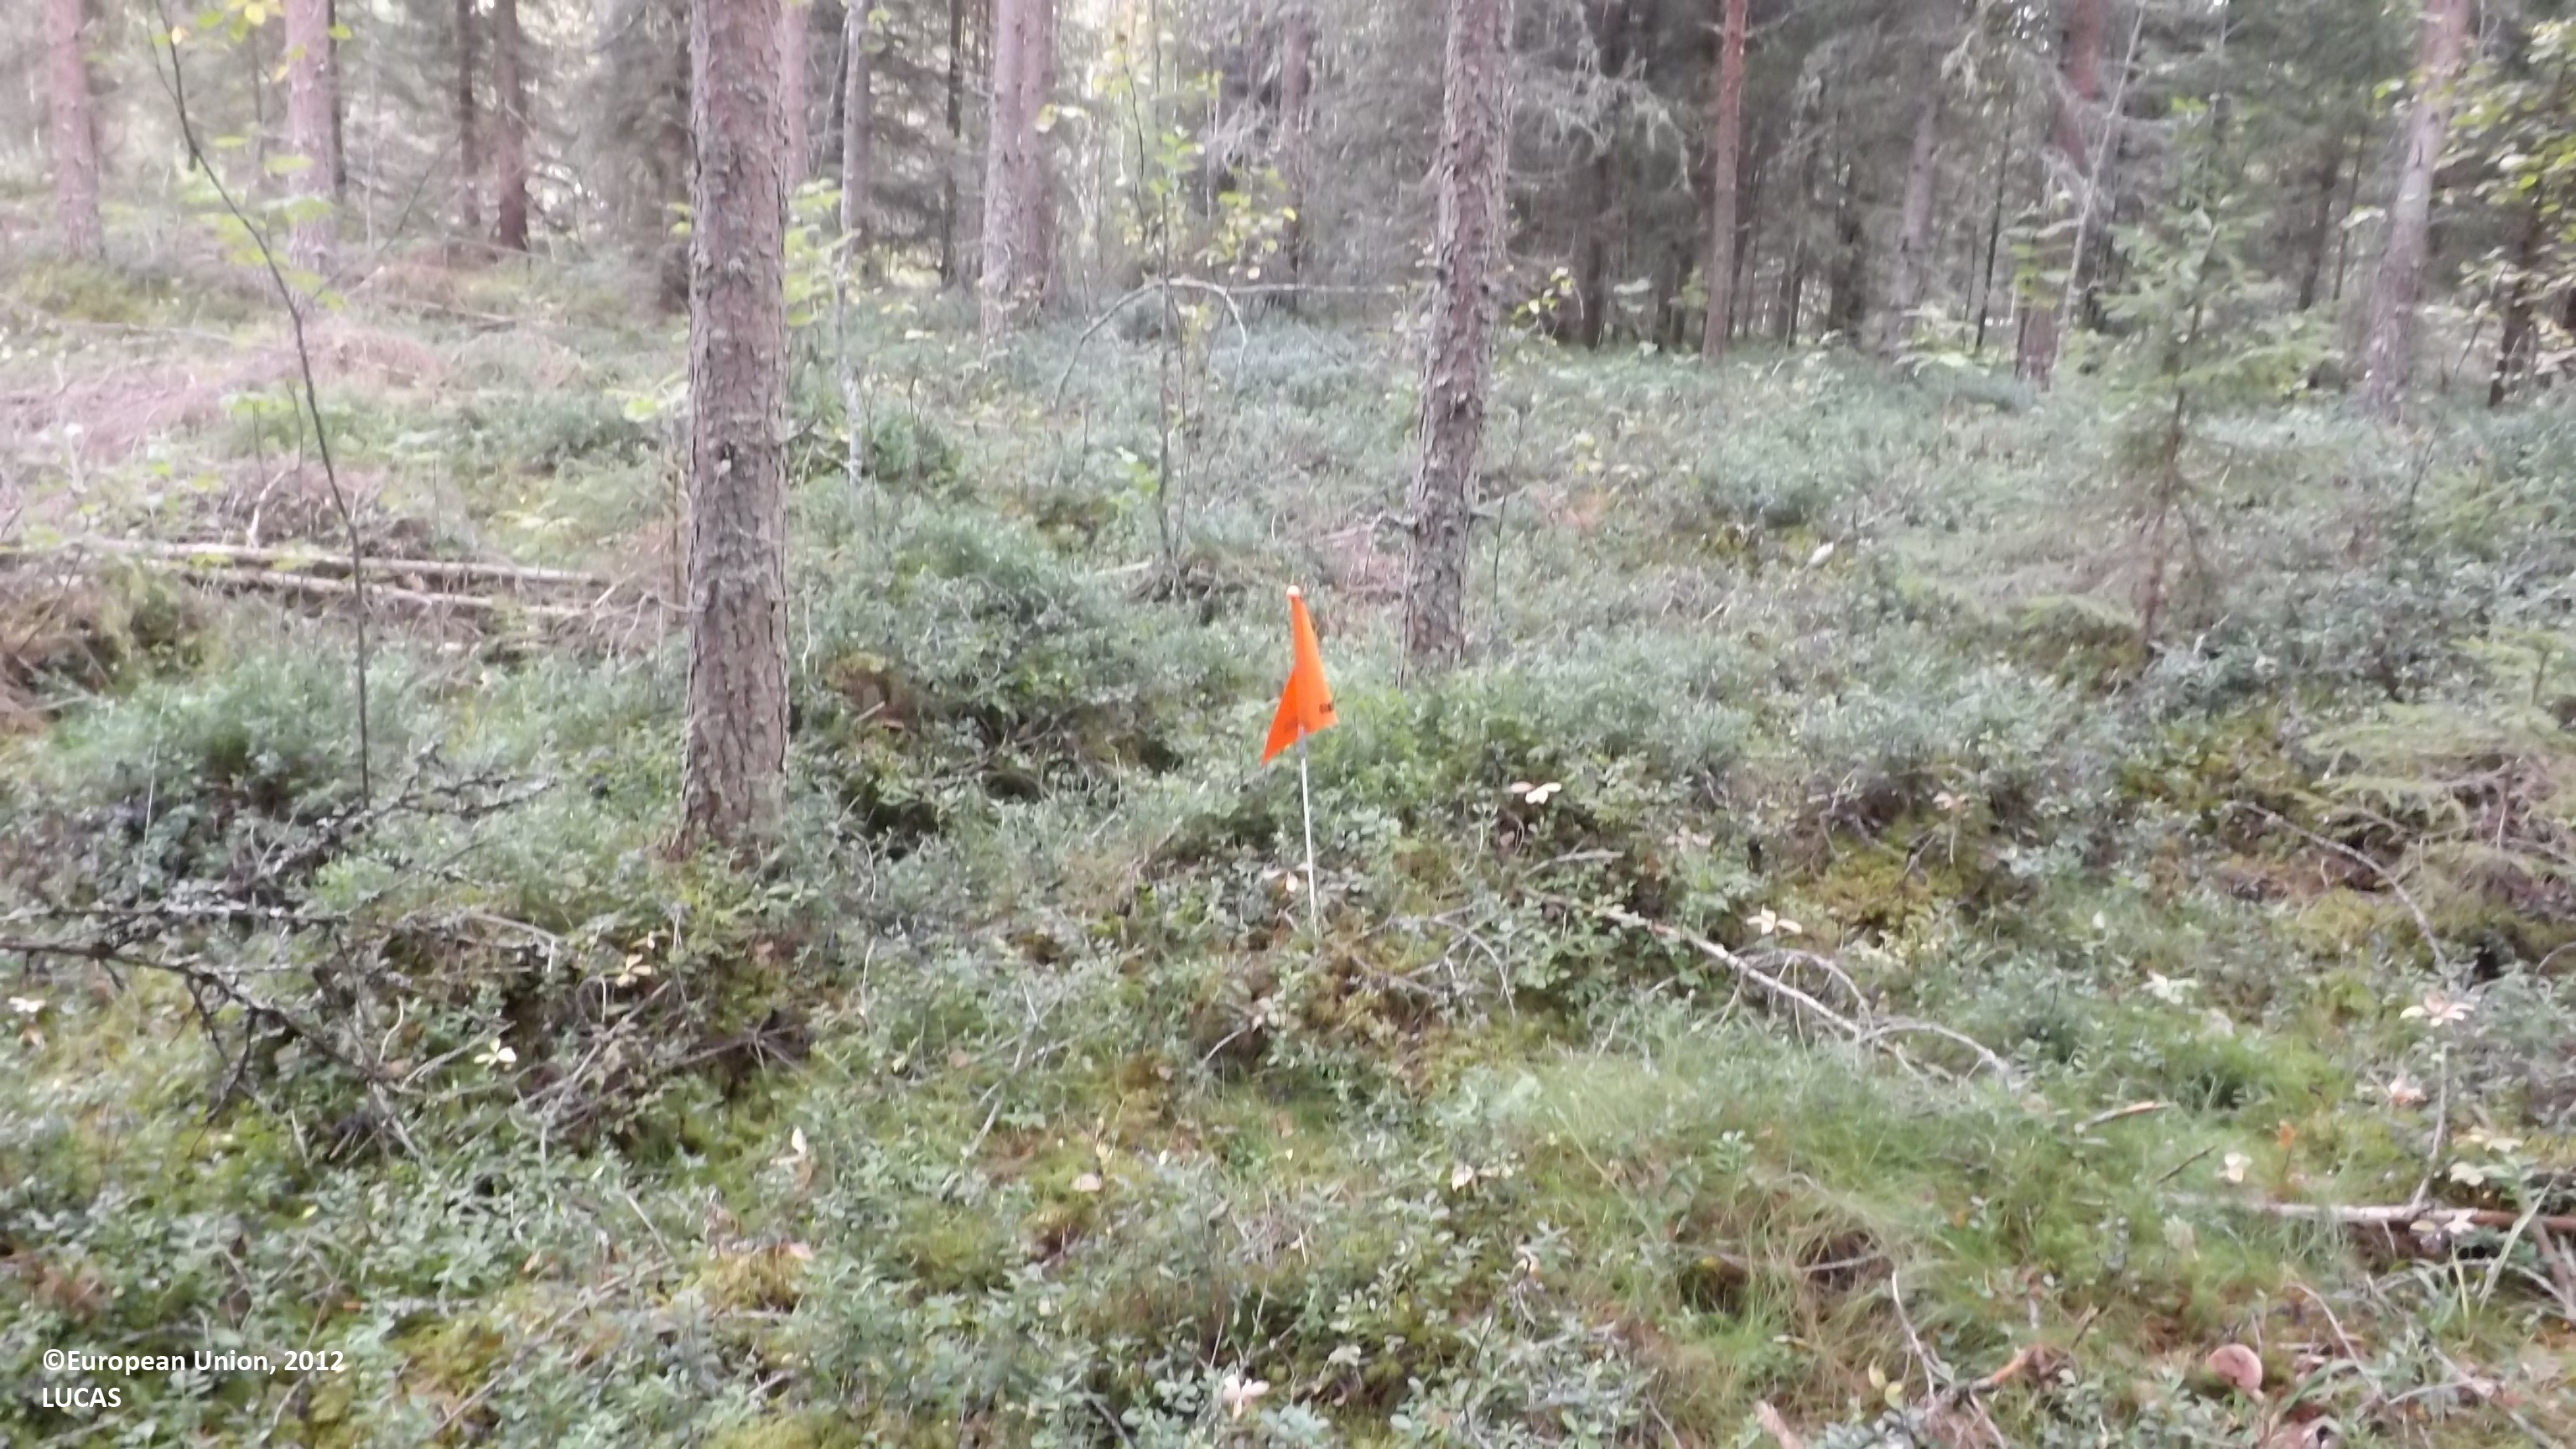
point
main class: Woodland
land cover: Pine dominated mixed woodland
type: boreal forest
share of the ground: 50 - 75 %
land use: Forestry
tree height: > 5 m
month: August
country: FI
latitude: 63.8227
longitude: 23.4470
